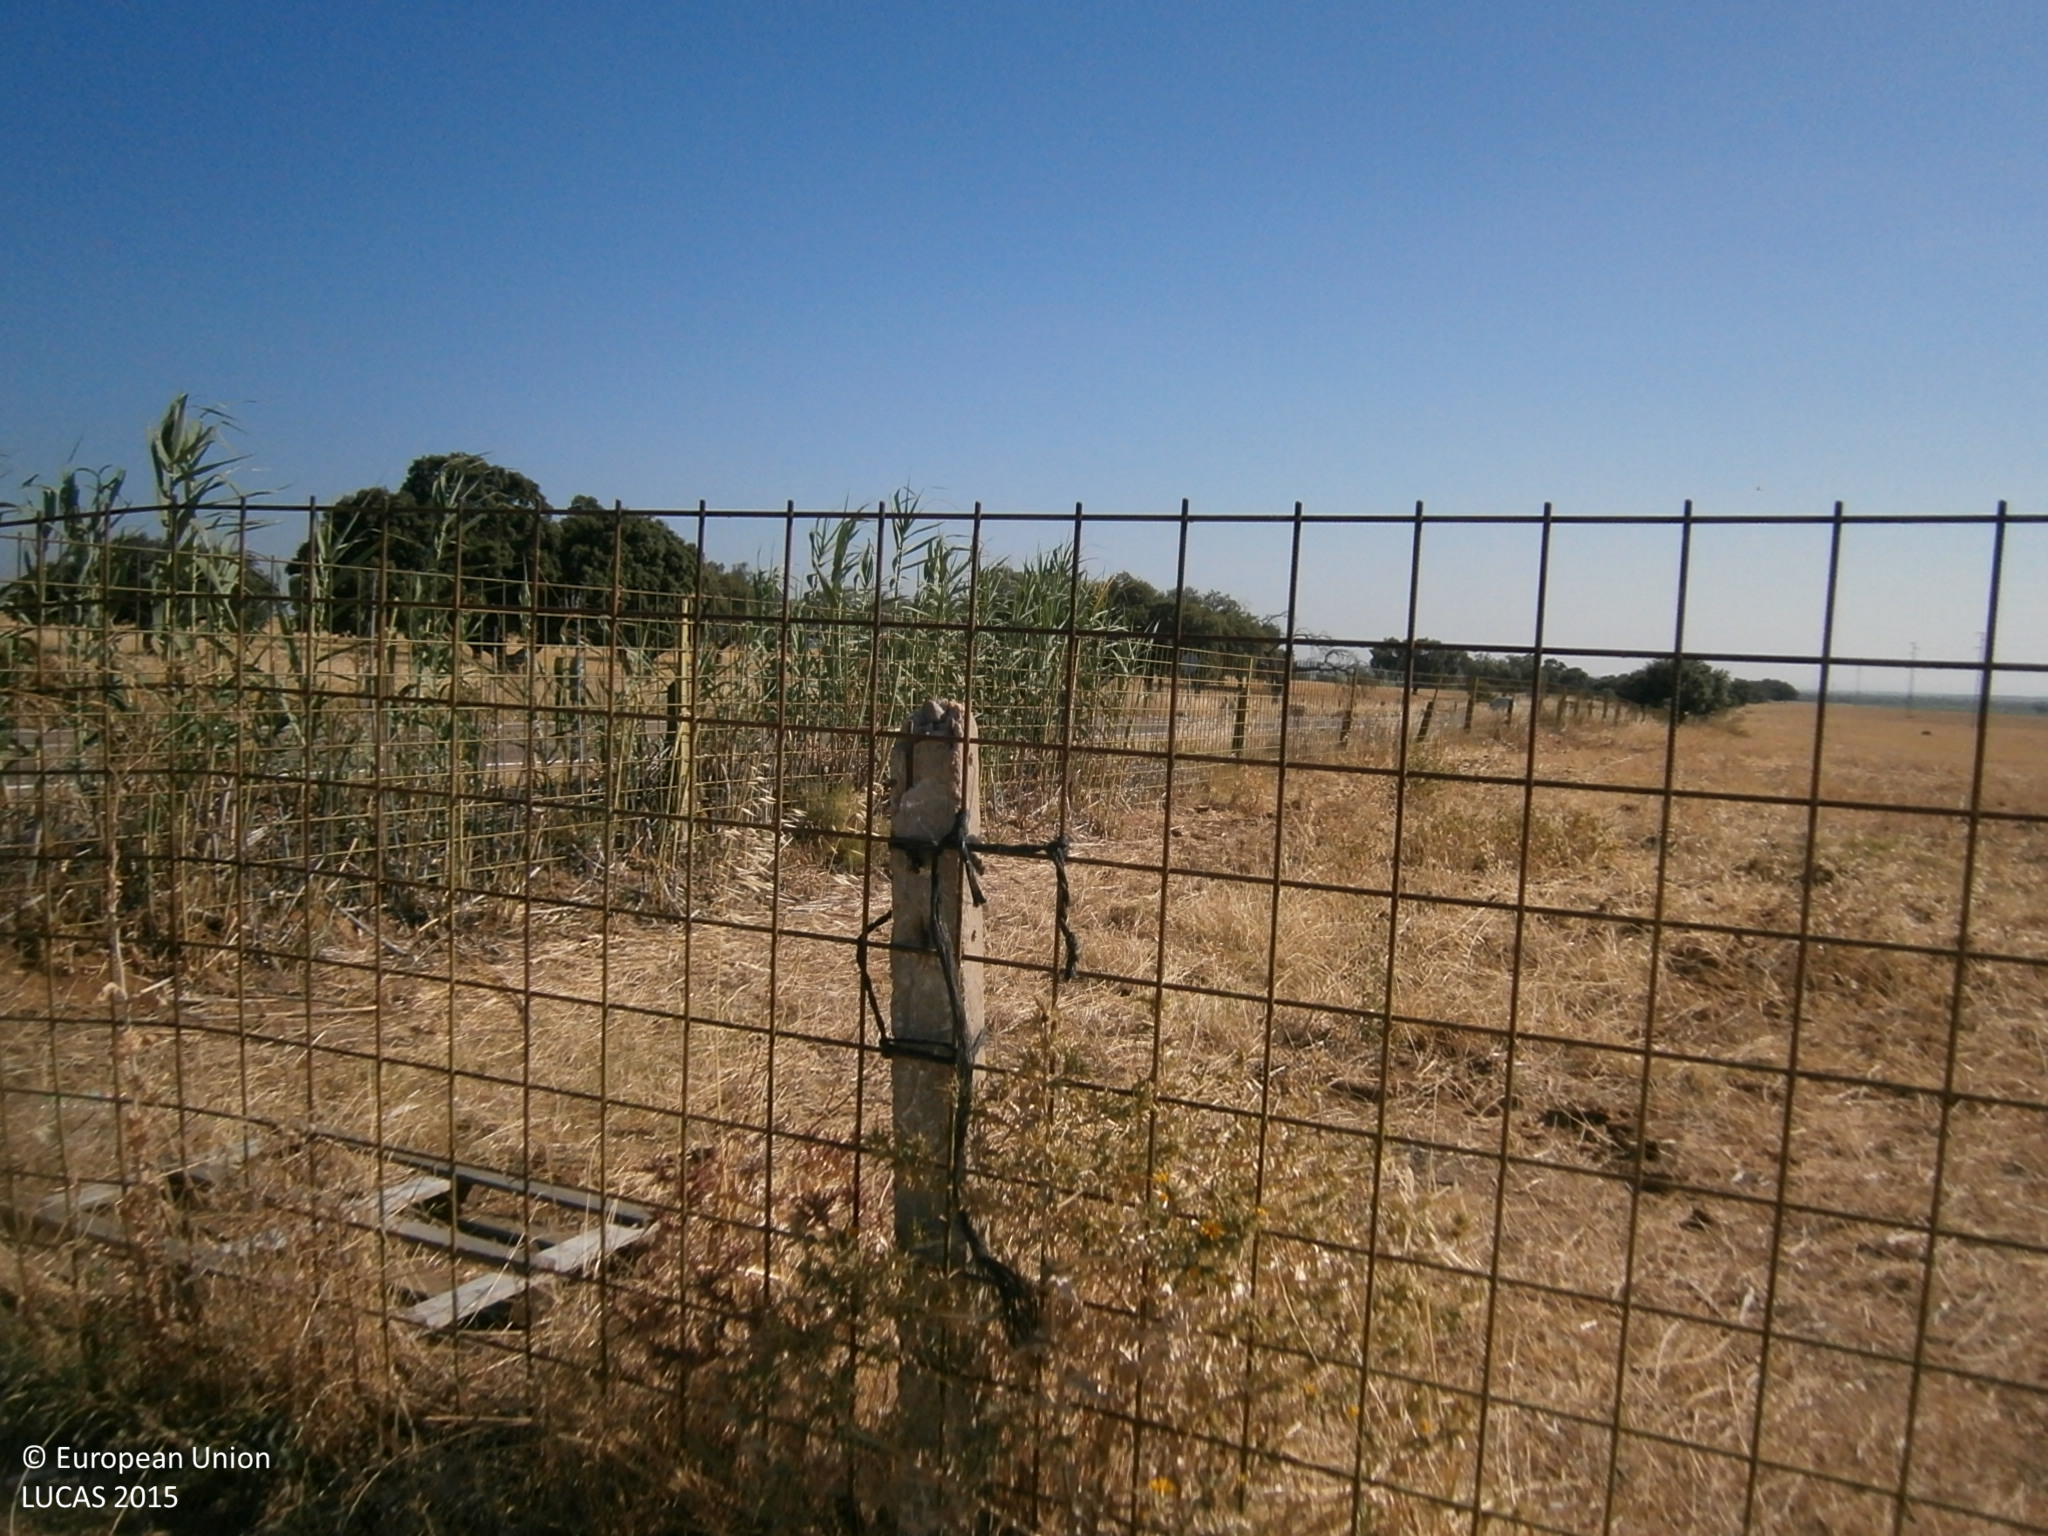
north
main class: Cropland
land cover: Maize
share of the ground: > 75 %
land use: Agriculture (excluding fallow land and kitchen gardens)
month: July
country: ES
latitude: 38.9542
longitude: -6.9056
